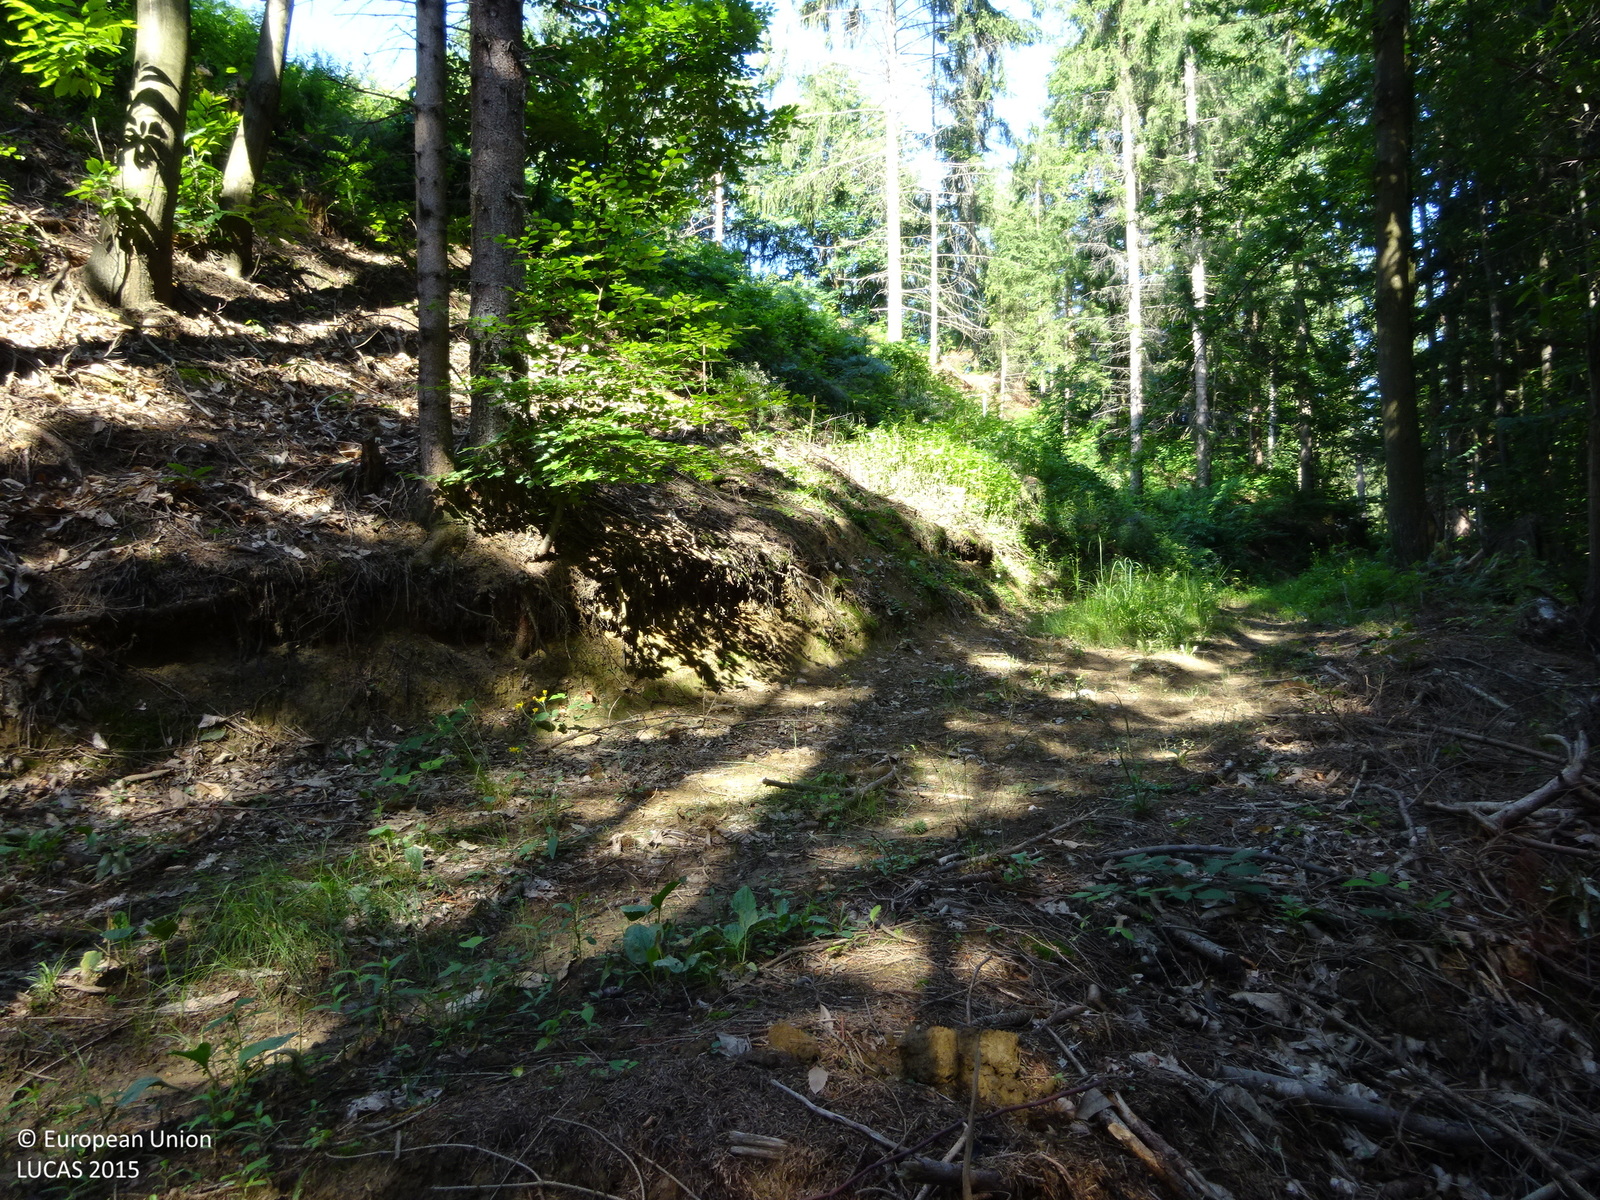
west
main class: Woodland
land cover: Spruce dominated coniferous woodland
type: alpine coniferous forest
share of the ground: > 75 %
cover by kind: coniferous forest trees 95 %, broadleaved forest trees 5 %
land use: Forestry
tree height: > 5 m
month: June
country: AT
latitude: 46.6727
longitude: 15.2665
